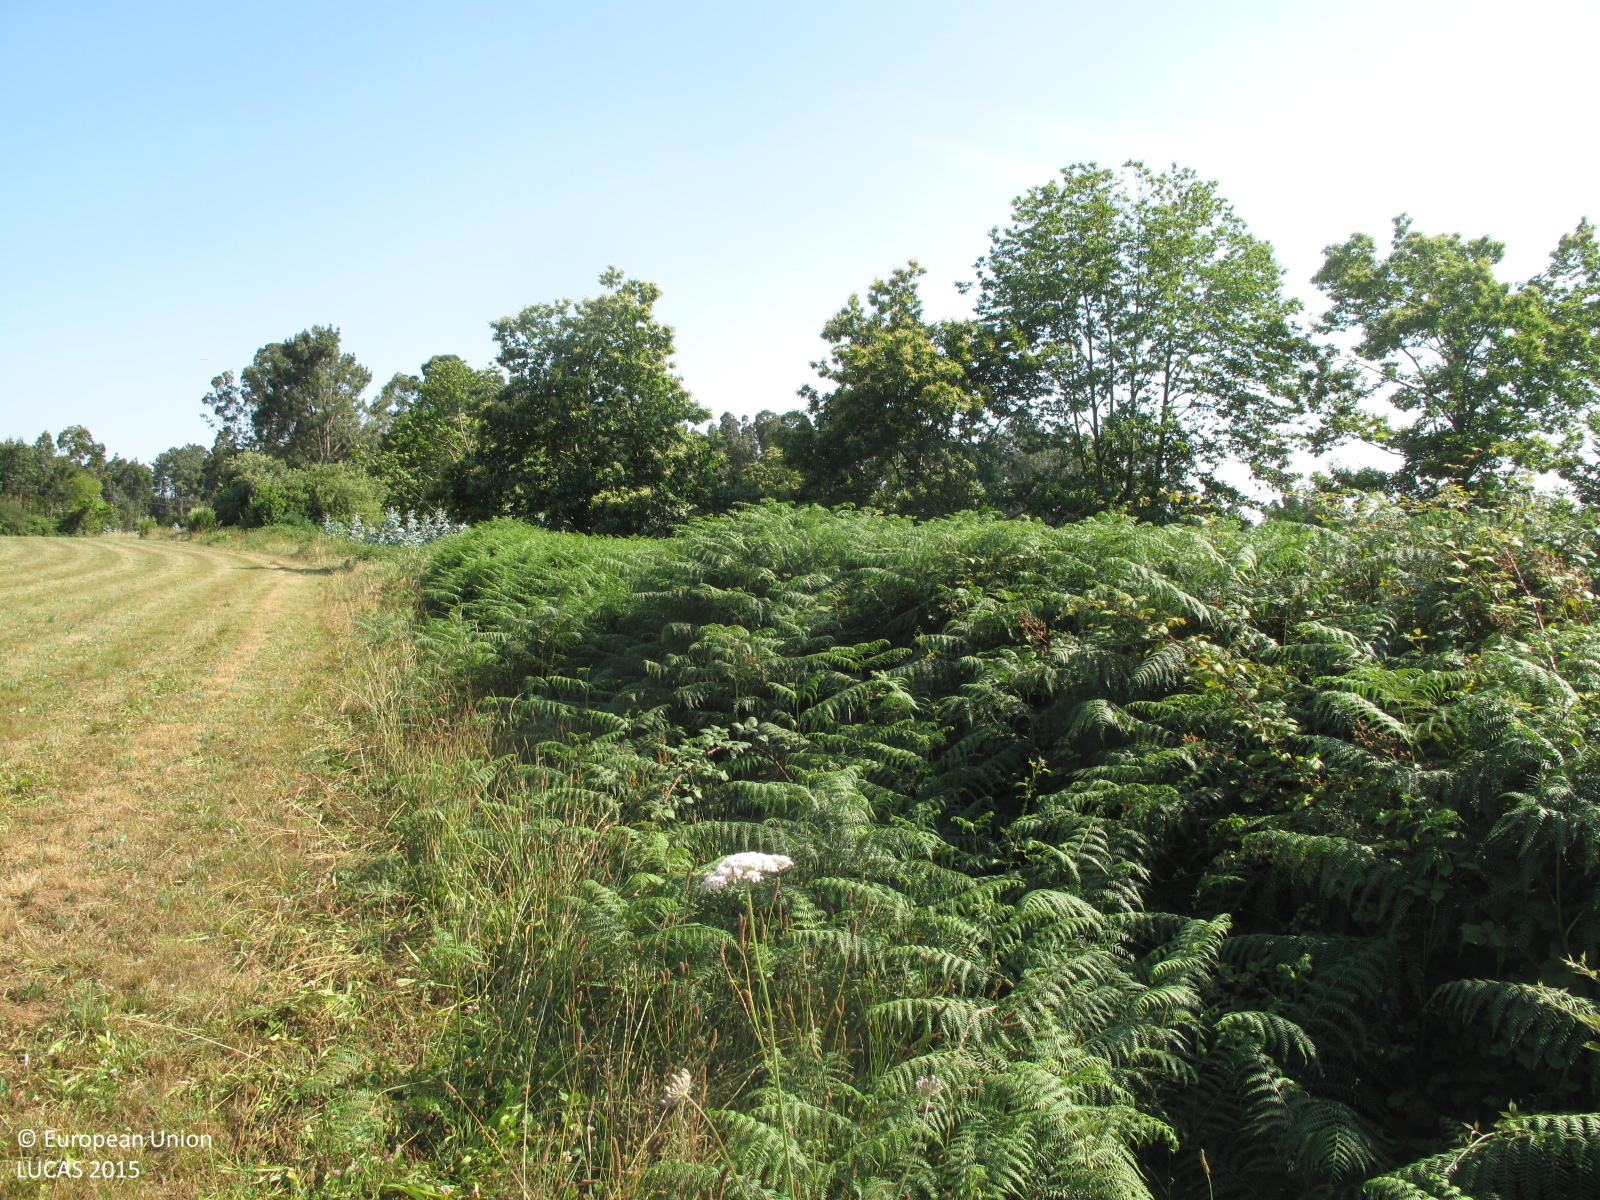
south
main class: Shrubland
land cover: Shrubland with sparse tree cover
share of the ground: 10 - 25 %
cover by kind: herbaceous plants 75 %, shrubs 20 %, broadleaved forest trees 5 %
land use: Abandoned areas
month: July
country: ES
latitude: 43.3431
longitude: -8.1455
